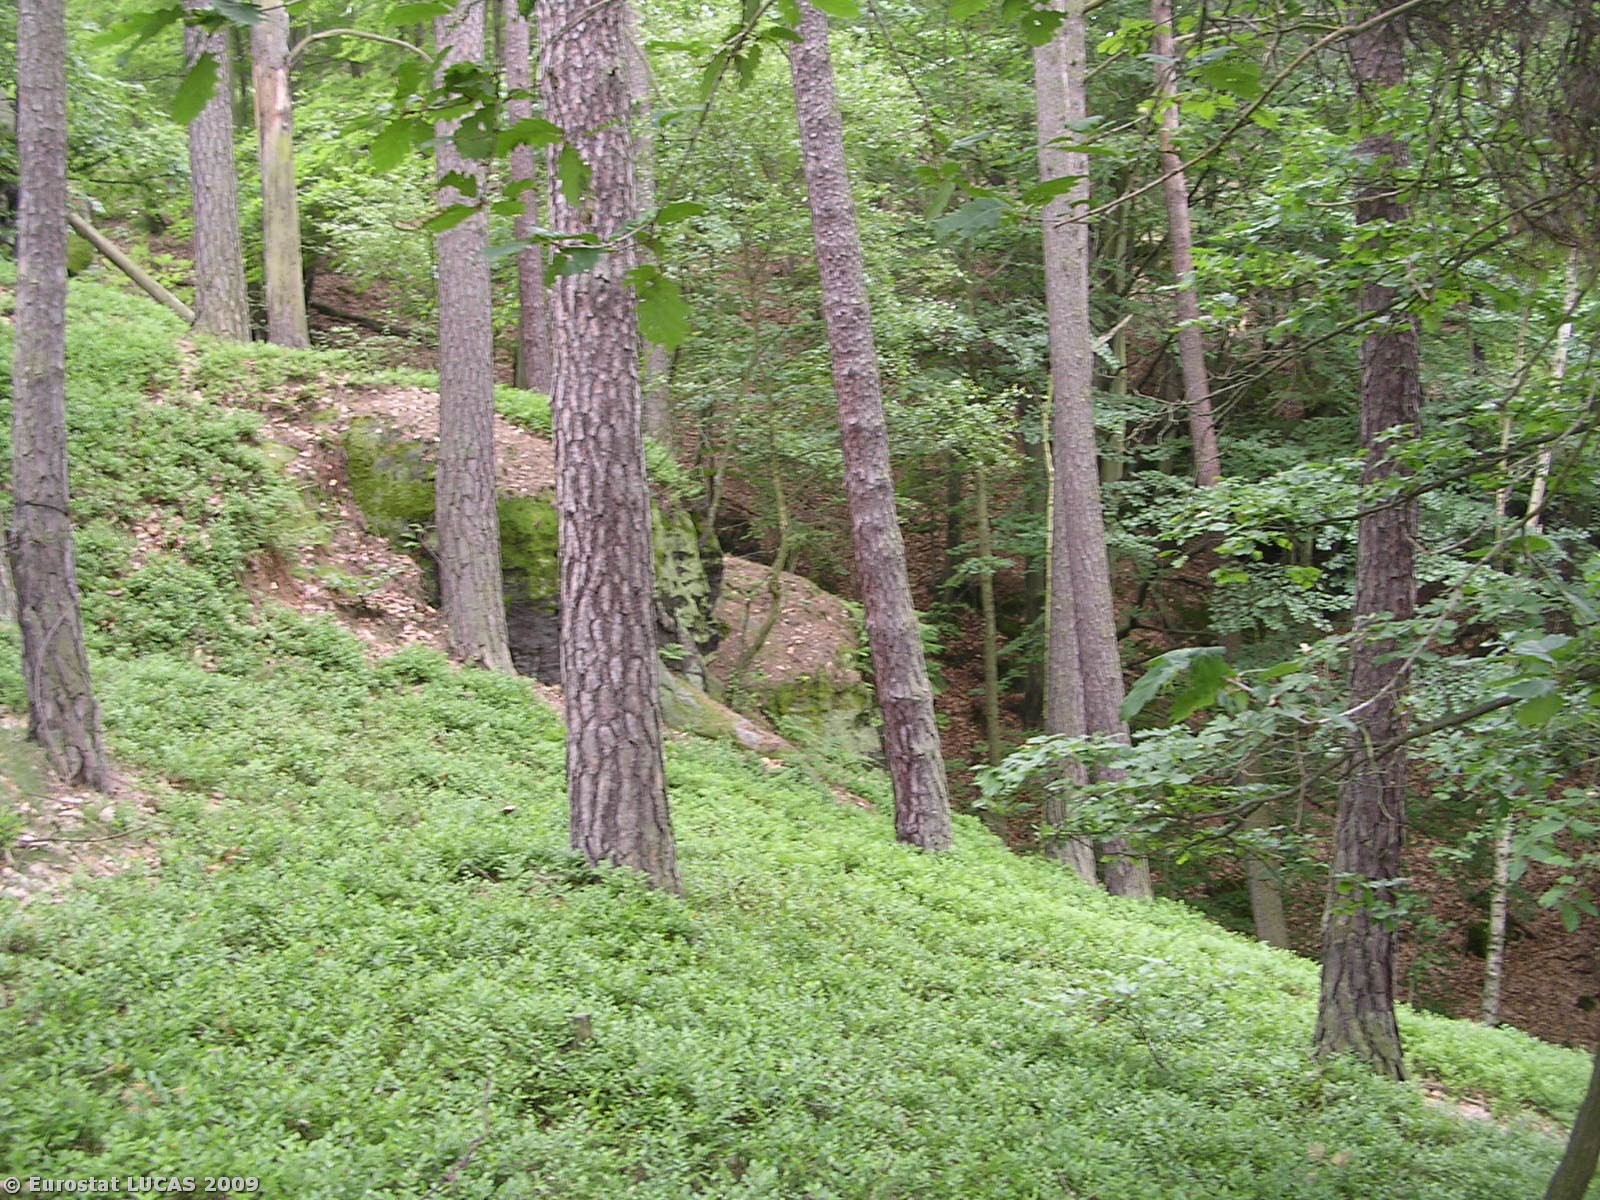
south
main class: Woodland
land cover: Mixed woodland
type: hemiboreal forest and nemoral coniferous forest and mixed broadleaved-coniferous forest
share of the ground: > 75 %
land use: Forestry
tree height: > 5 m
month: June
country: CZ
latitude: 50.5086
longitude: 14.5282
